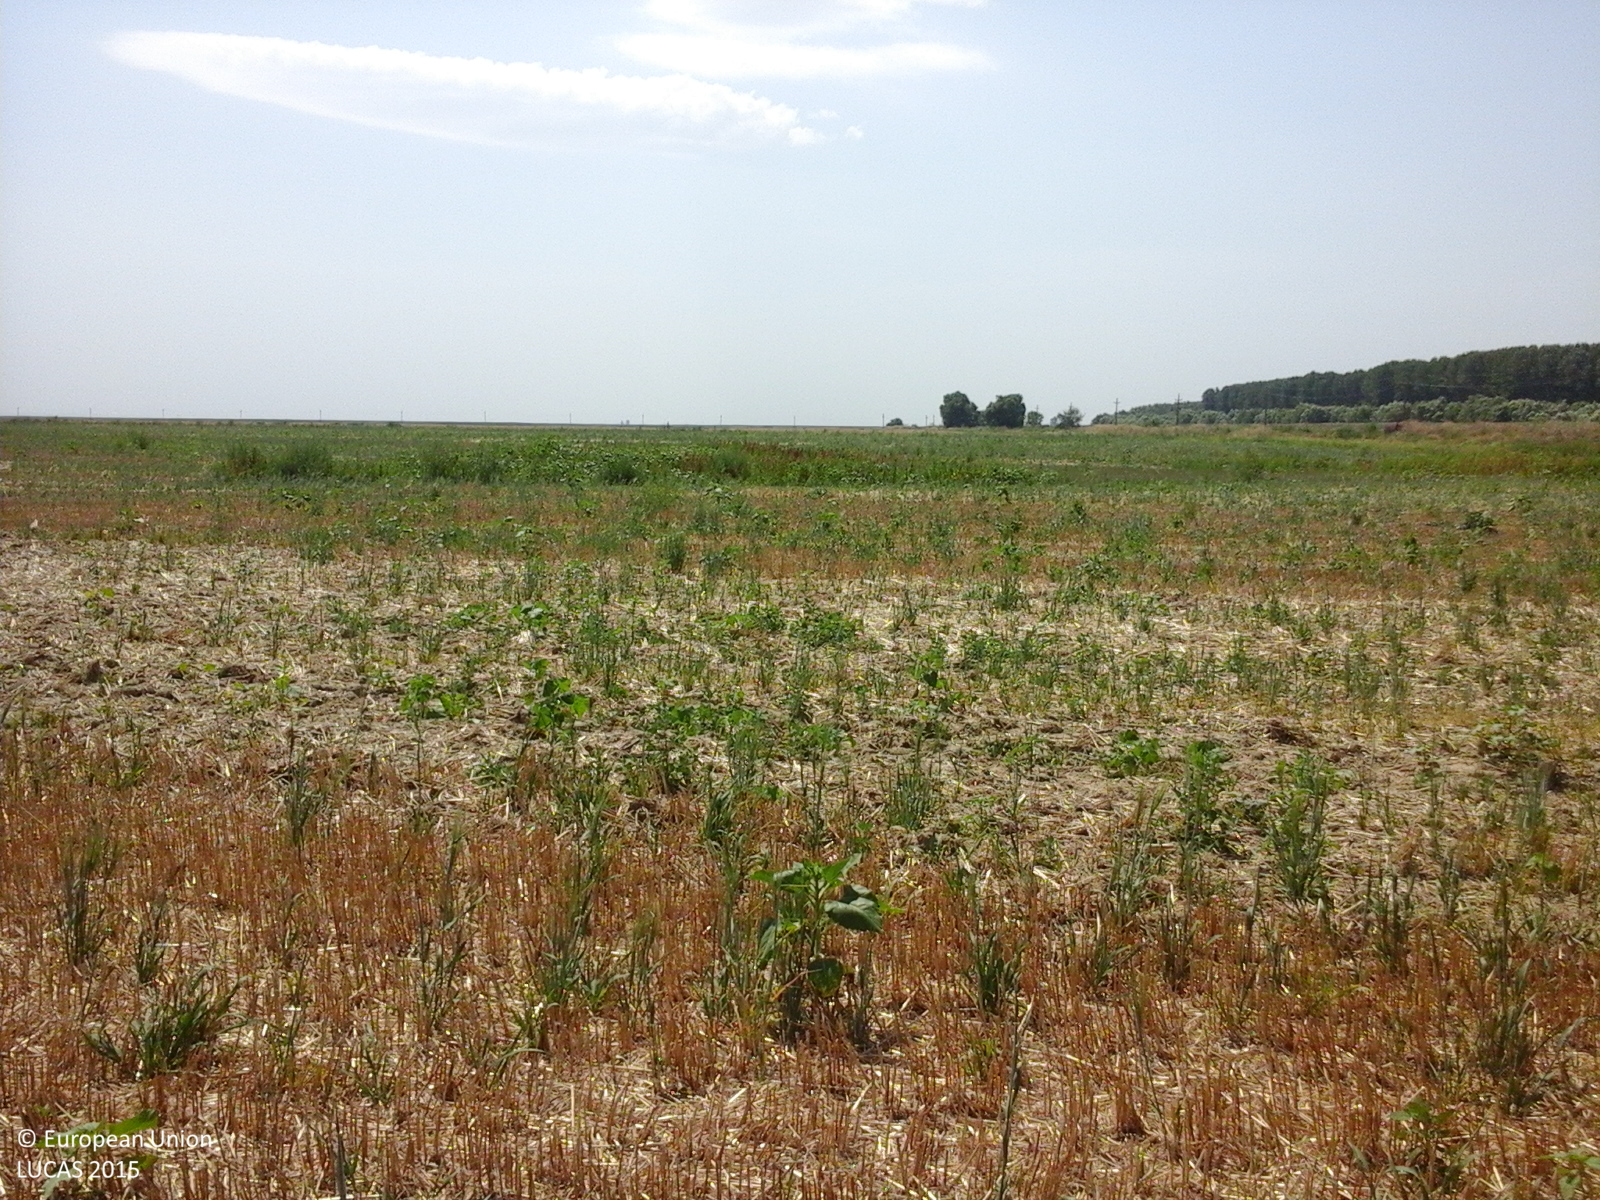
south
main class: Cropland
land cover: Soya
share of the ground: > 75 %
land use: Agriculture (excluding fallow land and kitchen gardens)
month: August
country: RO
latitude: 45.0208
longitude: 27.9413
